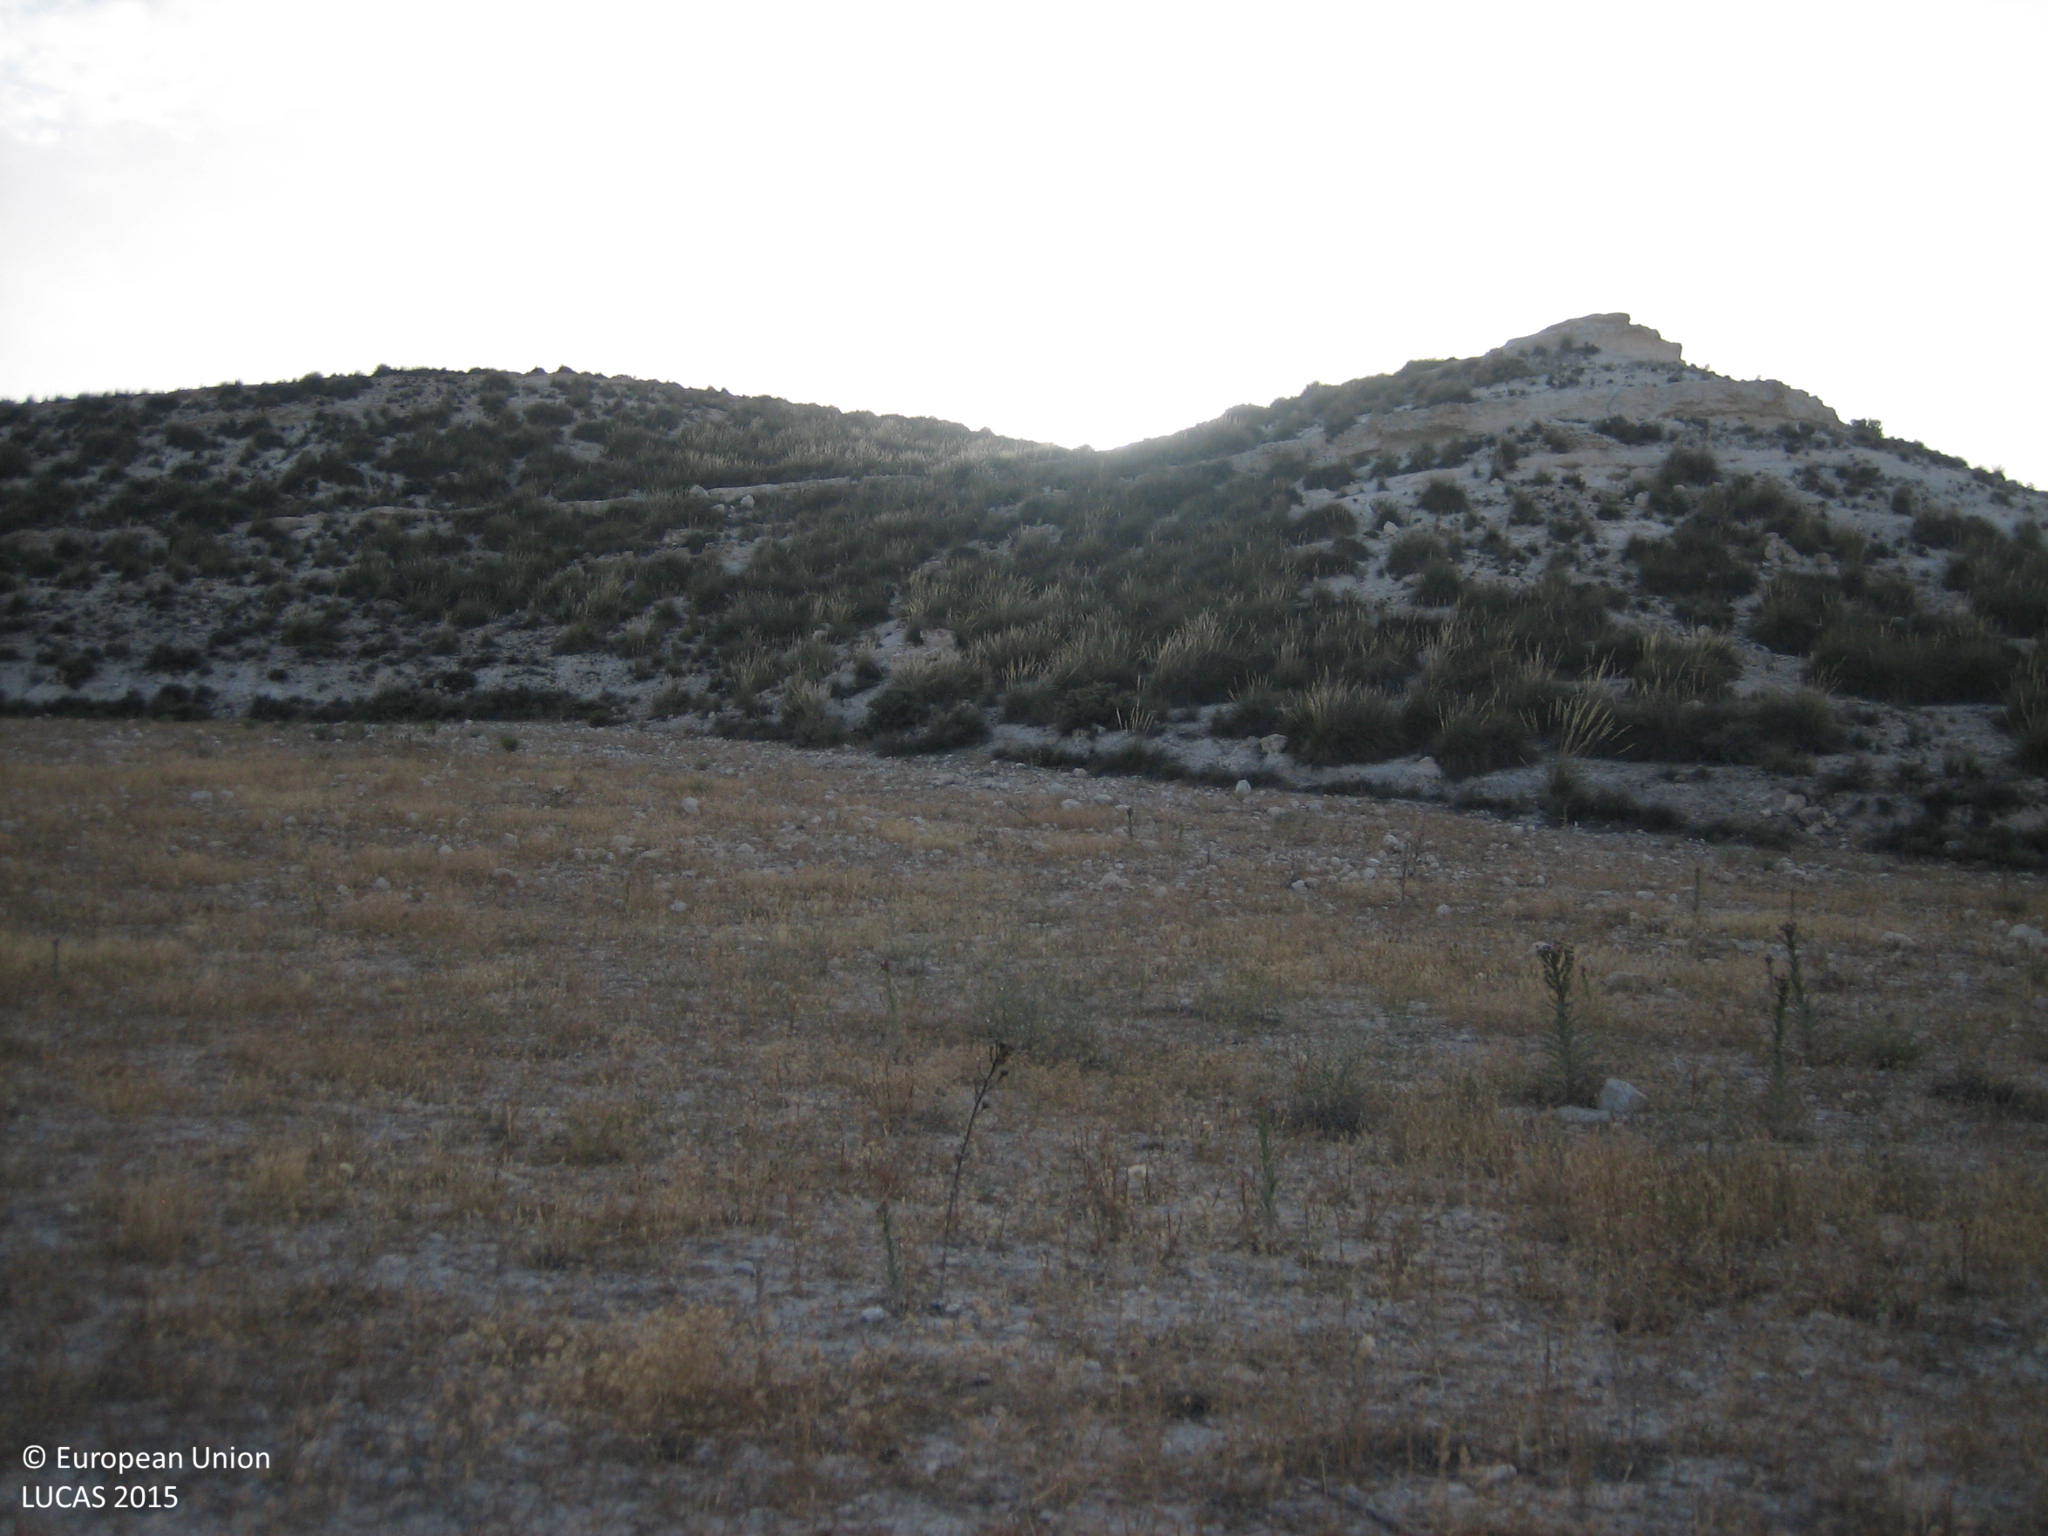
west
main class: Grassland
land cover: Spontaneously vegetated surfaces
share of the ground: 25 - 50 %
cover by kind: unconsolidated bare surface 70 %, herbaceous plants 30 %
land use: Fallow land
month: July
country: ES
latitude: 37.7370
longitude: -2.4135
